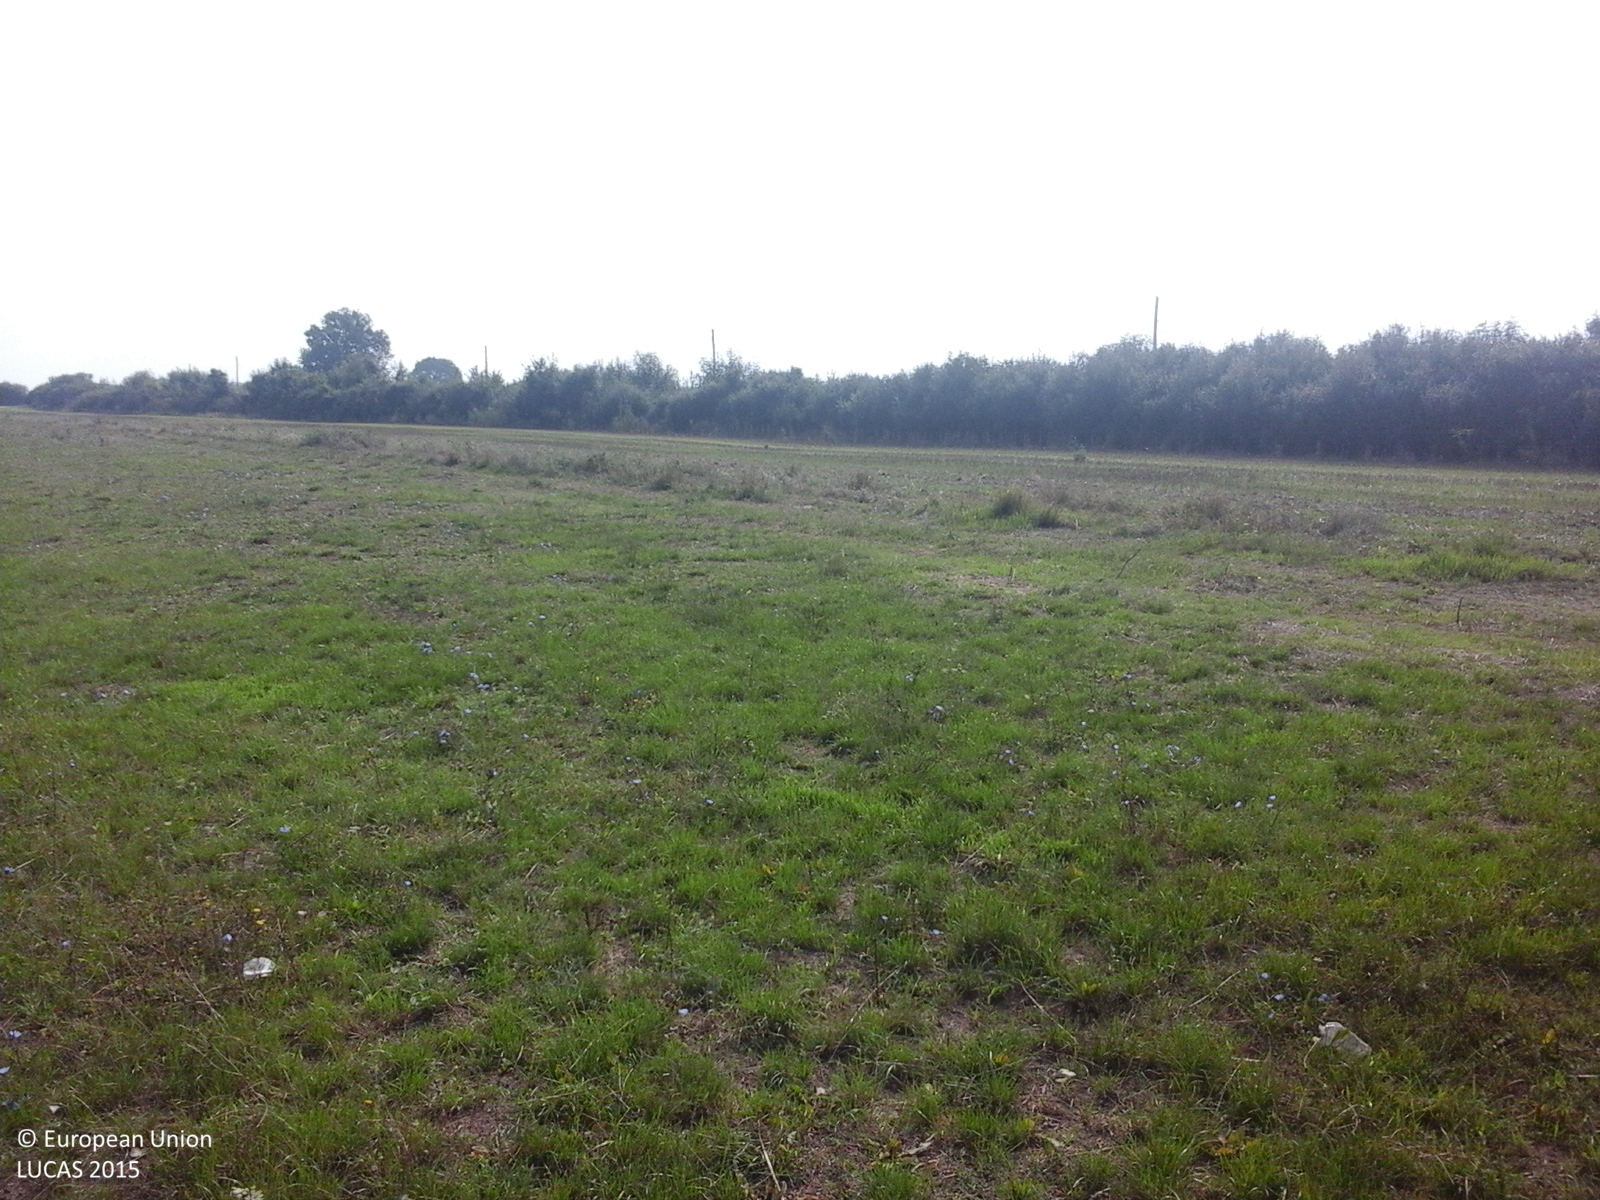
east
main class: Grassland
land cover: Grassland without tree/shrub cover
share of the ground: > 75 %
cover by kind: herbaceous plants 100 %
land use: Agriculture (excluding fallow land and kitchen gardens)
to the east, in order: Grassland without tree/shrub cover; Common wheat; Grass margins; Abandoned hedges; Ditches and canals; Grass margins; Paved roads, cycling and walking lanes; Grass margins; Ditches and canals; Shrubland with sparse tree cover; Electric lines; Shrubland with sparse tree cover
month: August
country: RO
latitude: 46.5506
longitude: 21.6344
